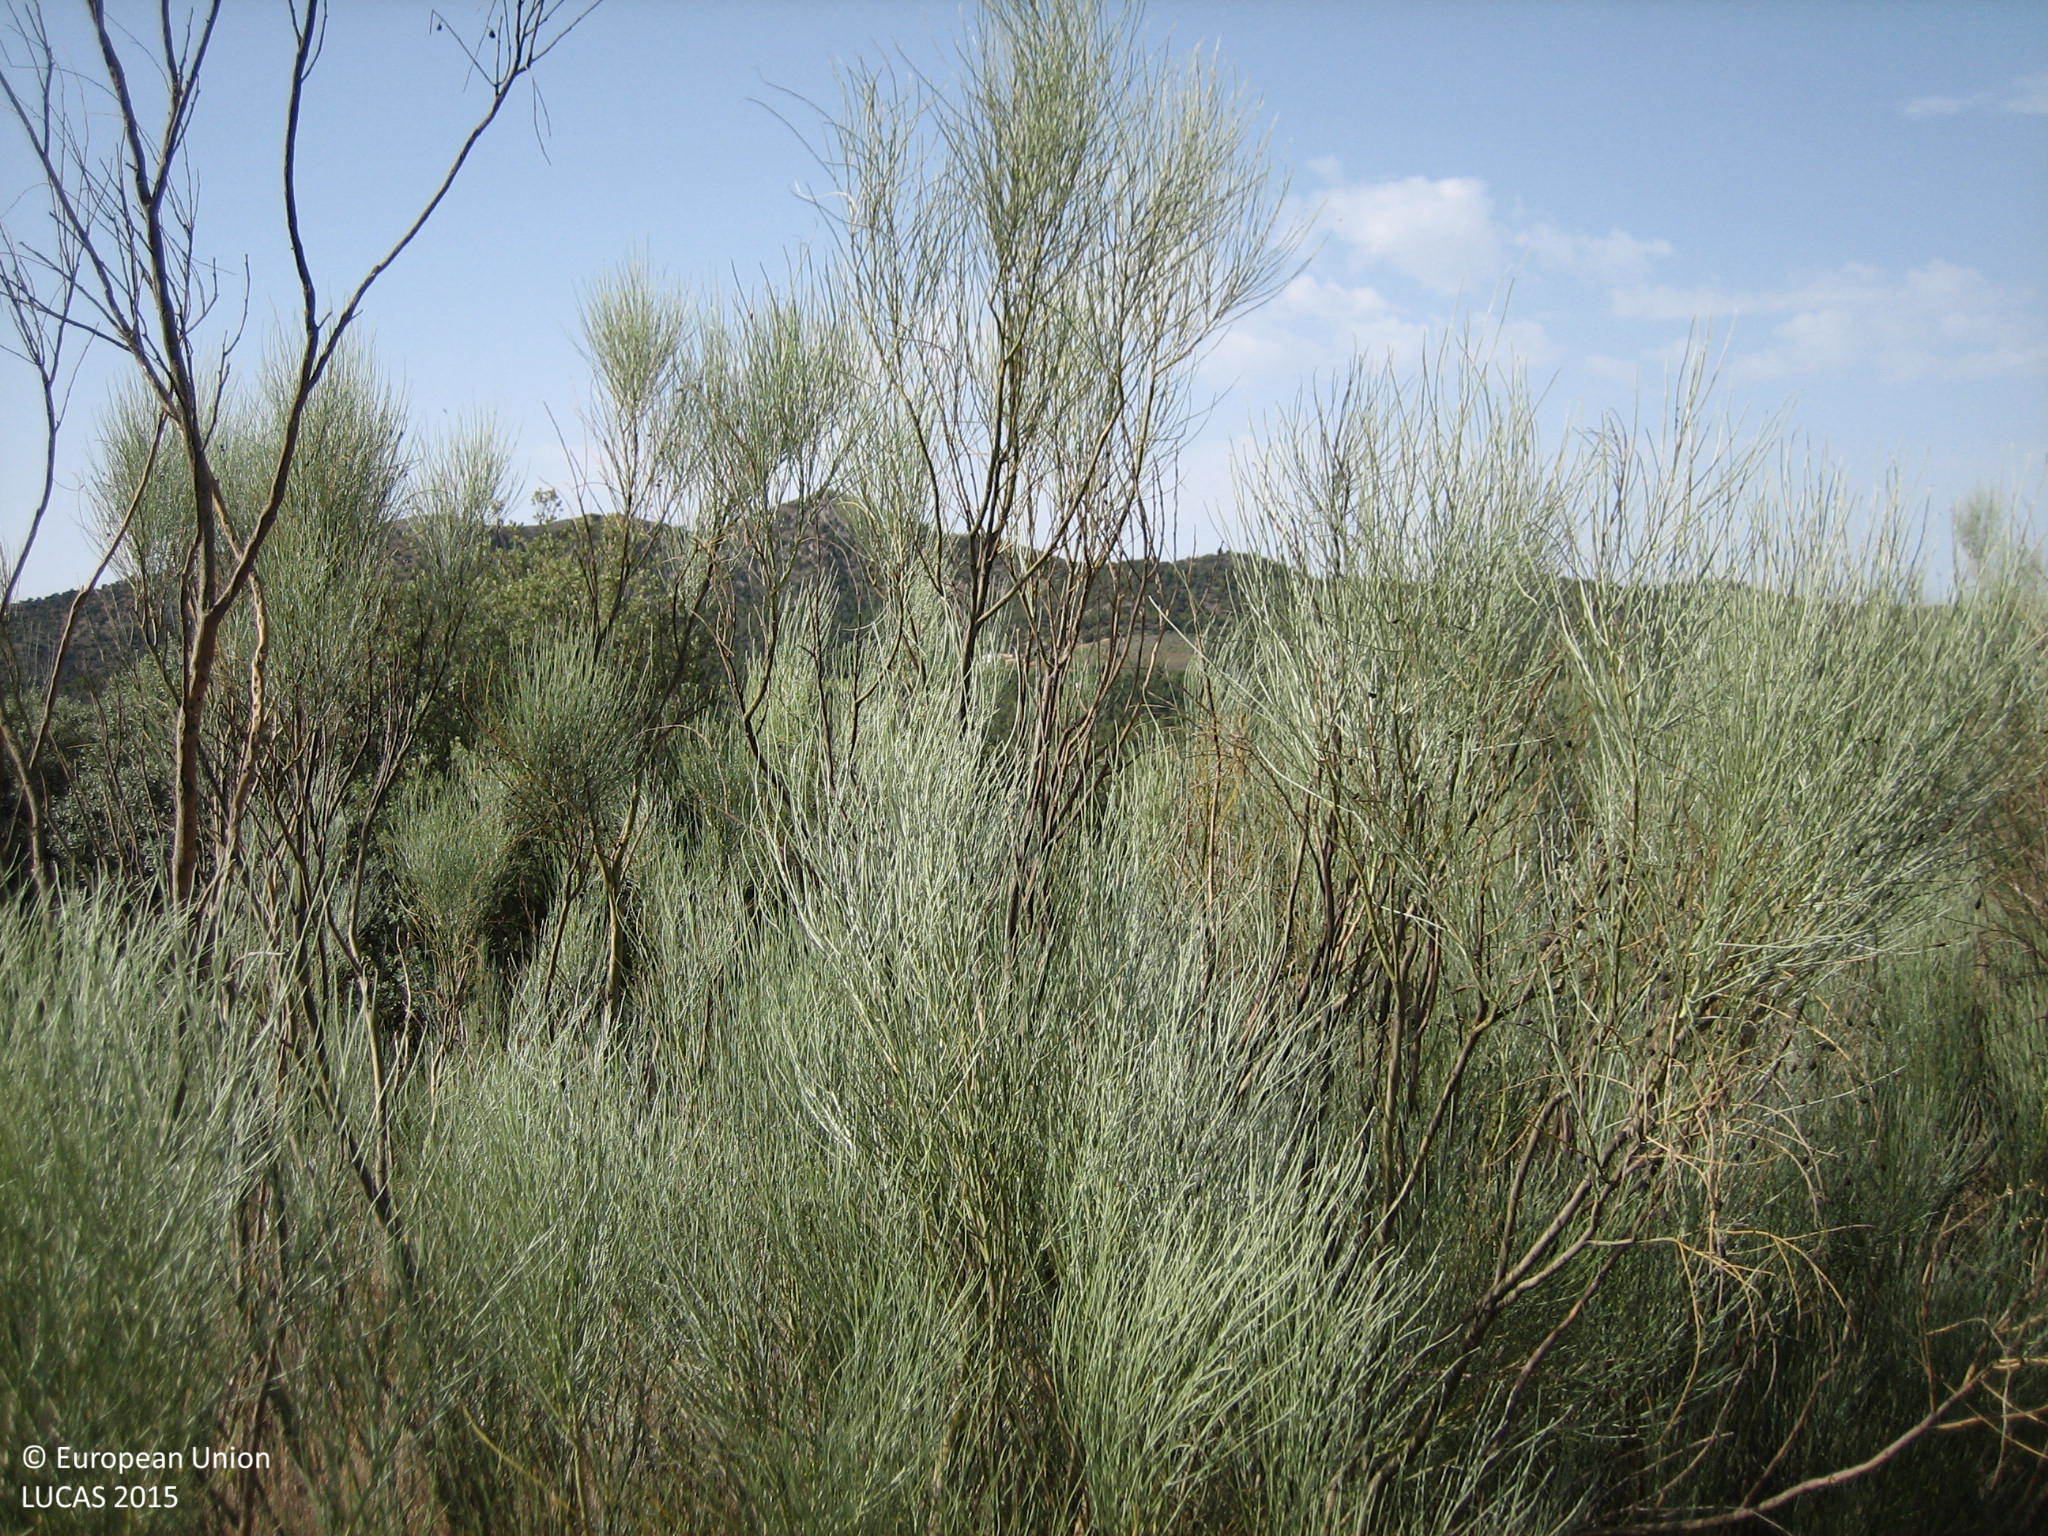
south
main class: Cropland
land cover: Nuts trees
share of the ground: < 10 %
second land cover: Other bare soil
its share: > 75 %
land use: Agriculture (excluding fallow land and kitchen gardens)
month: July
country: ES
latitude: 37.5432
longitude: -2.3554
